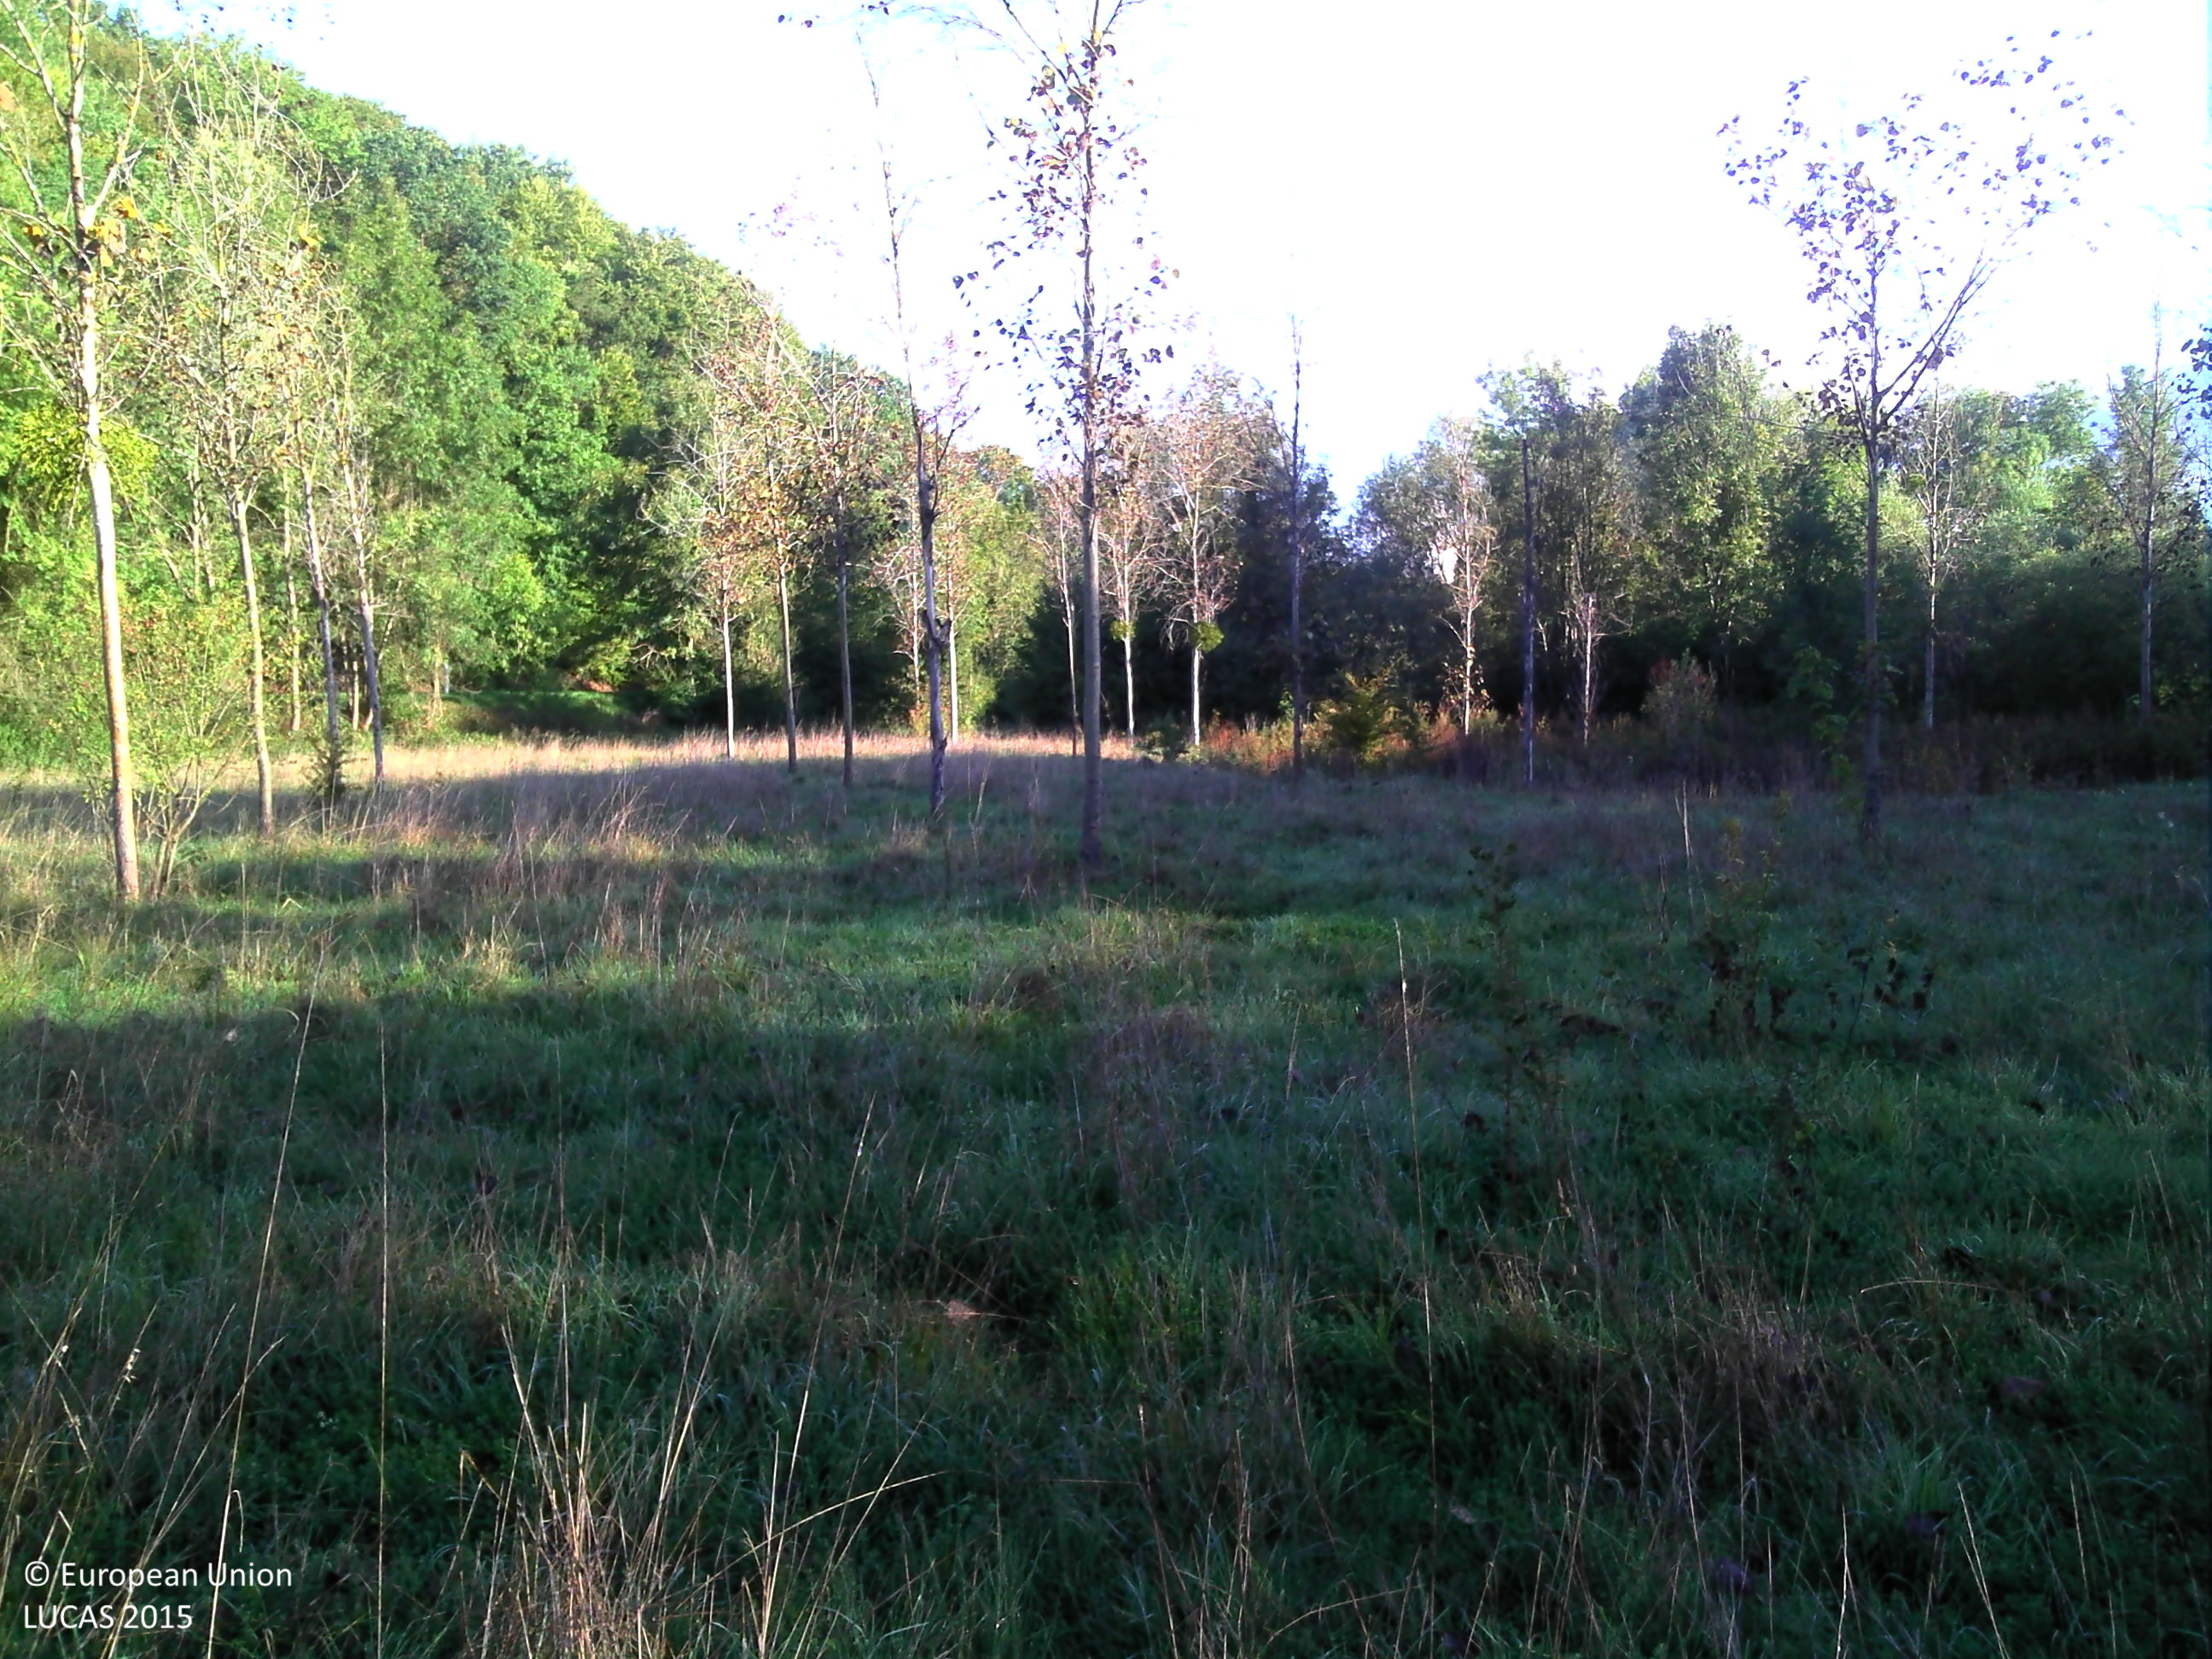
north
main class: Woodland
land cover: Broadleaved woodland
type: exotic forest
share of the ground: 25 - 50 %
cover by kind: herbaceous plants 65 %, broadleaved forest trees 35 %
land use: Forestry
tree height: > 5 m
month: September
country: FR
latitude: 48.1548
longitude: 4.7961
